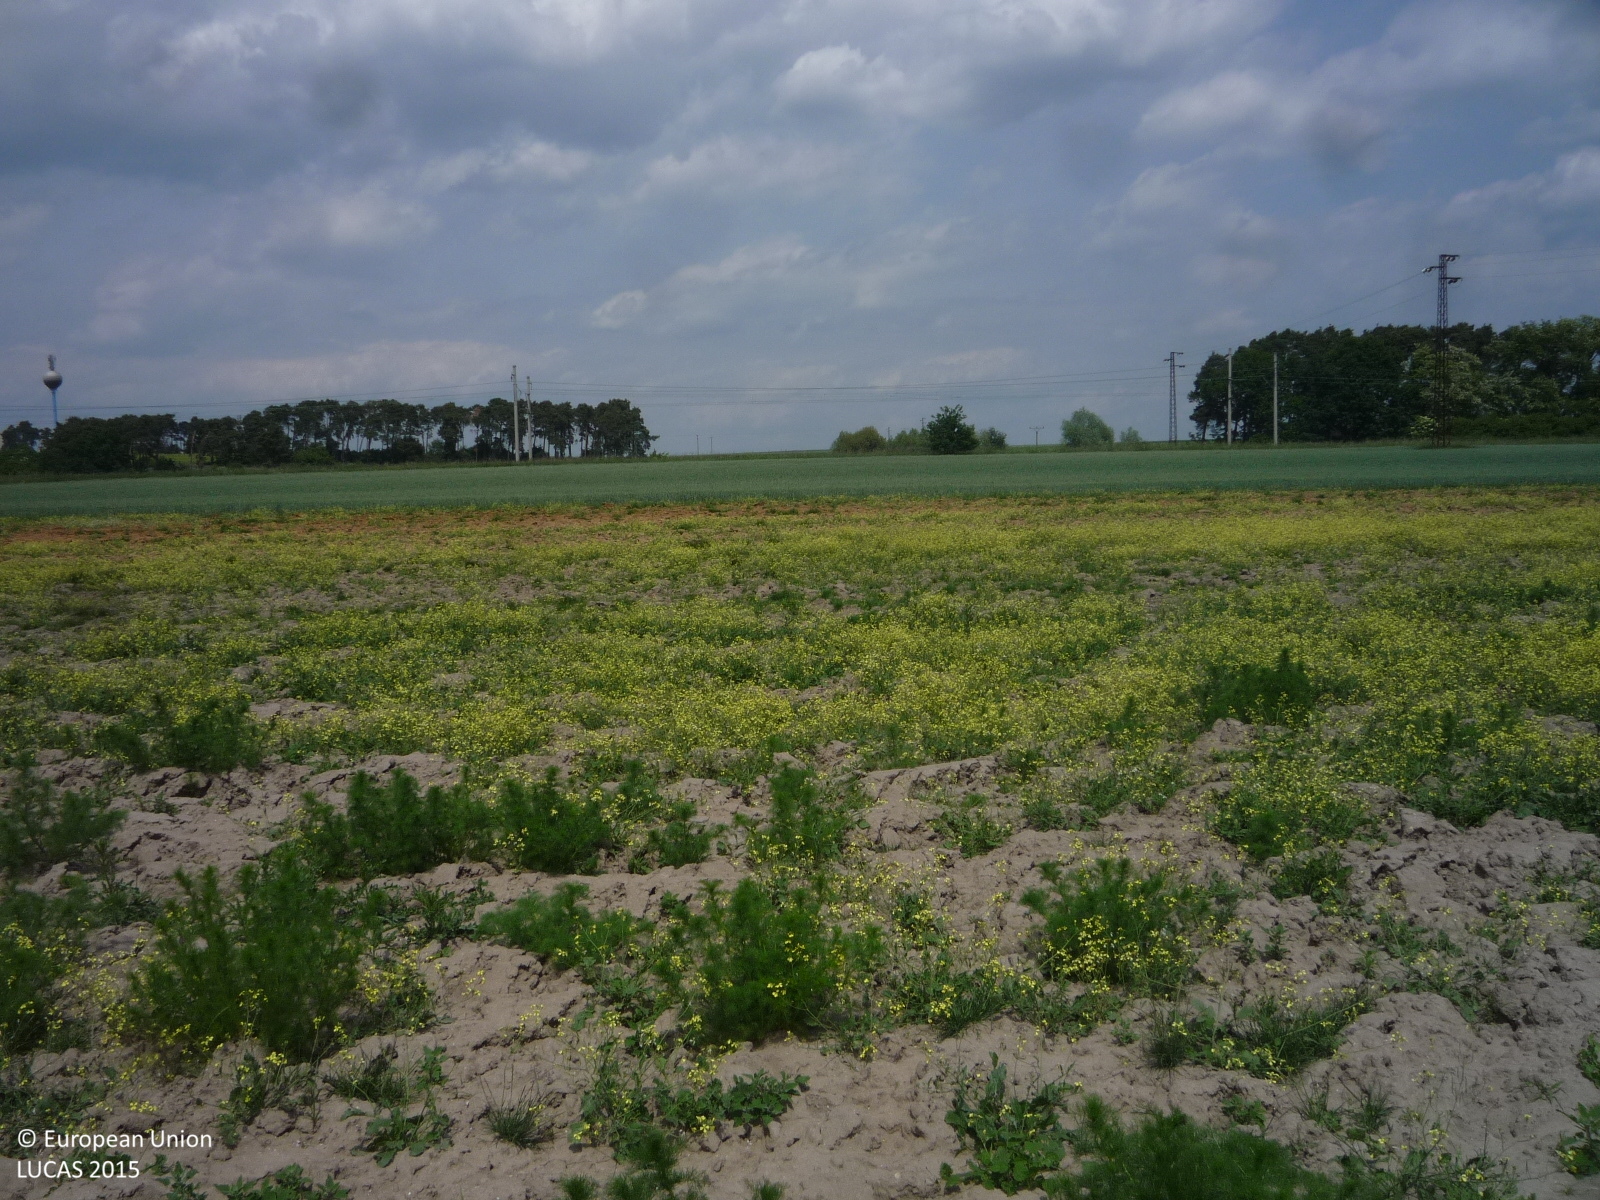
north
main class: Grassland
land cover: Spontaneously vegetated surfaces
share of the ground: 25 - 50 %
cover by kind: unconsolidated bare surface 55 %, herbaceous plants 45 %
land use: Fallow land
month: May
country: CZ
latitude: 50.1863
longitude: 14.9185
